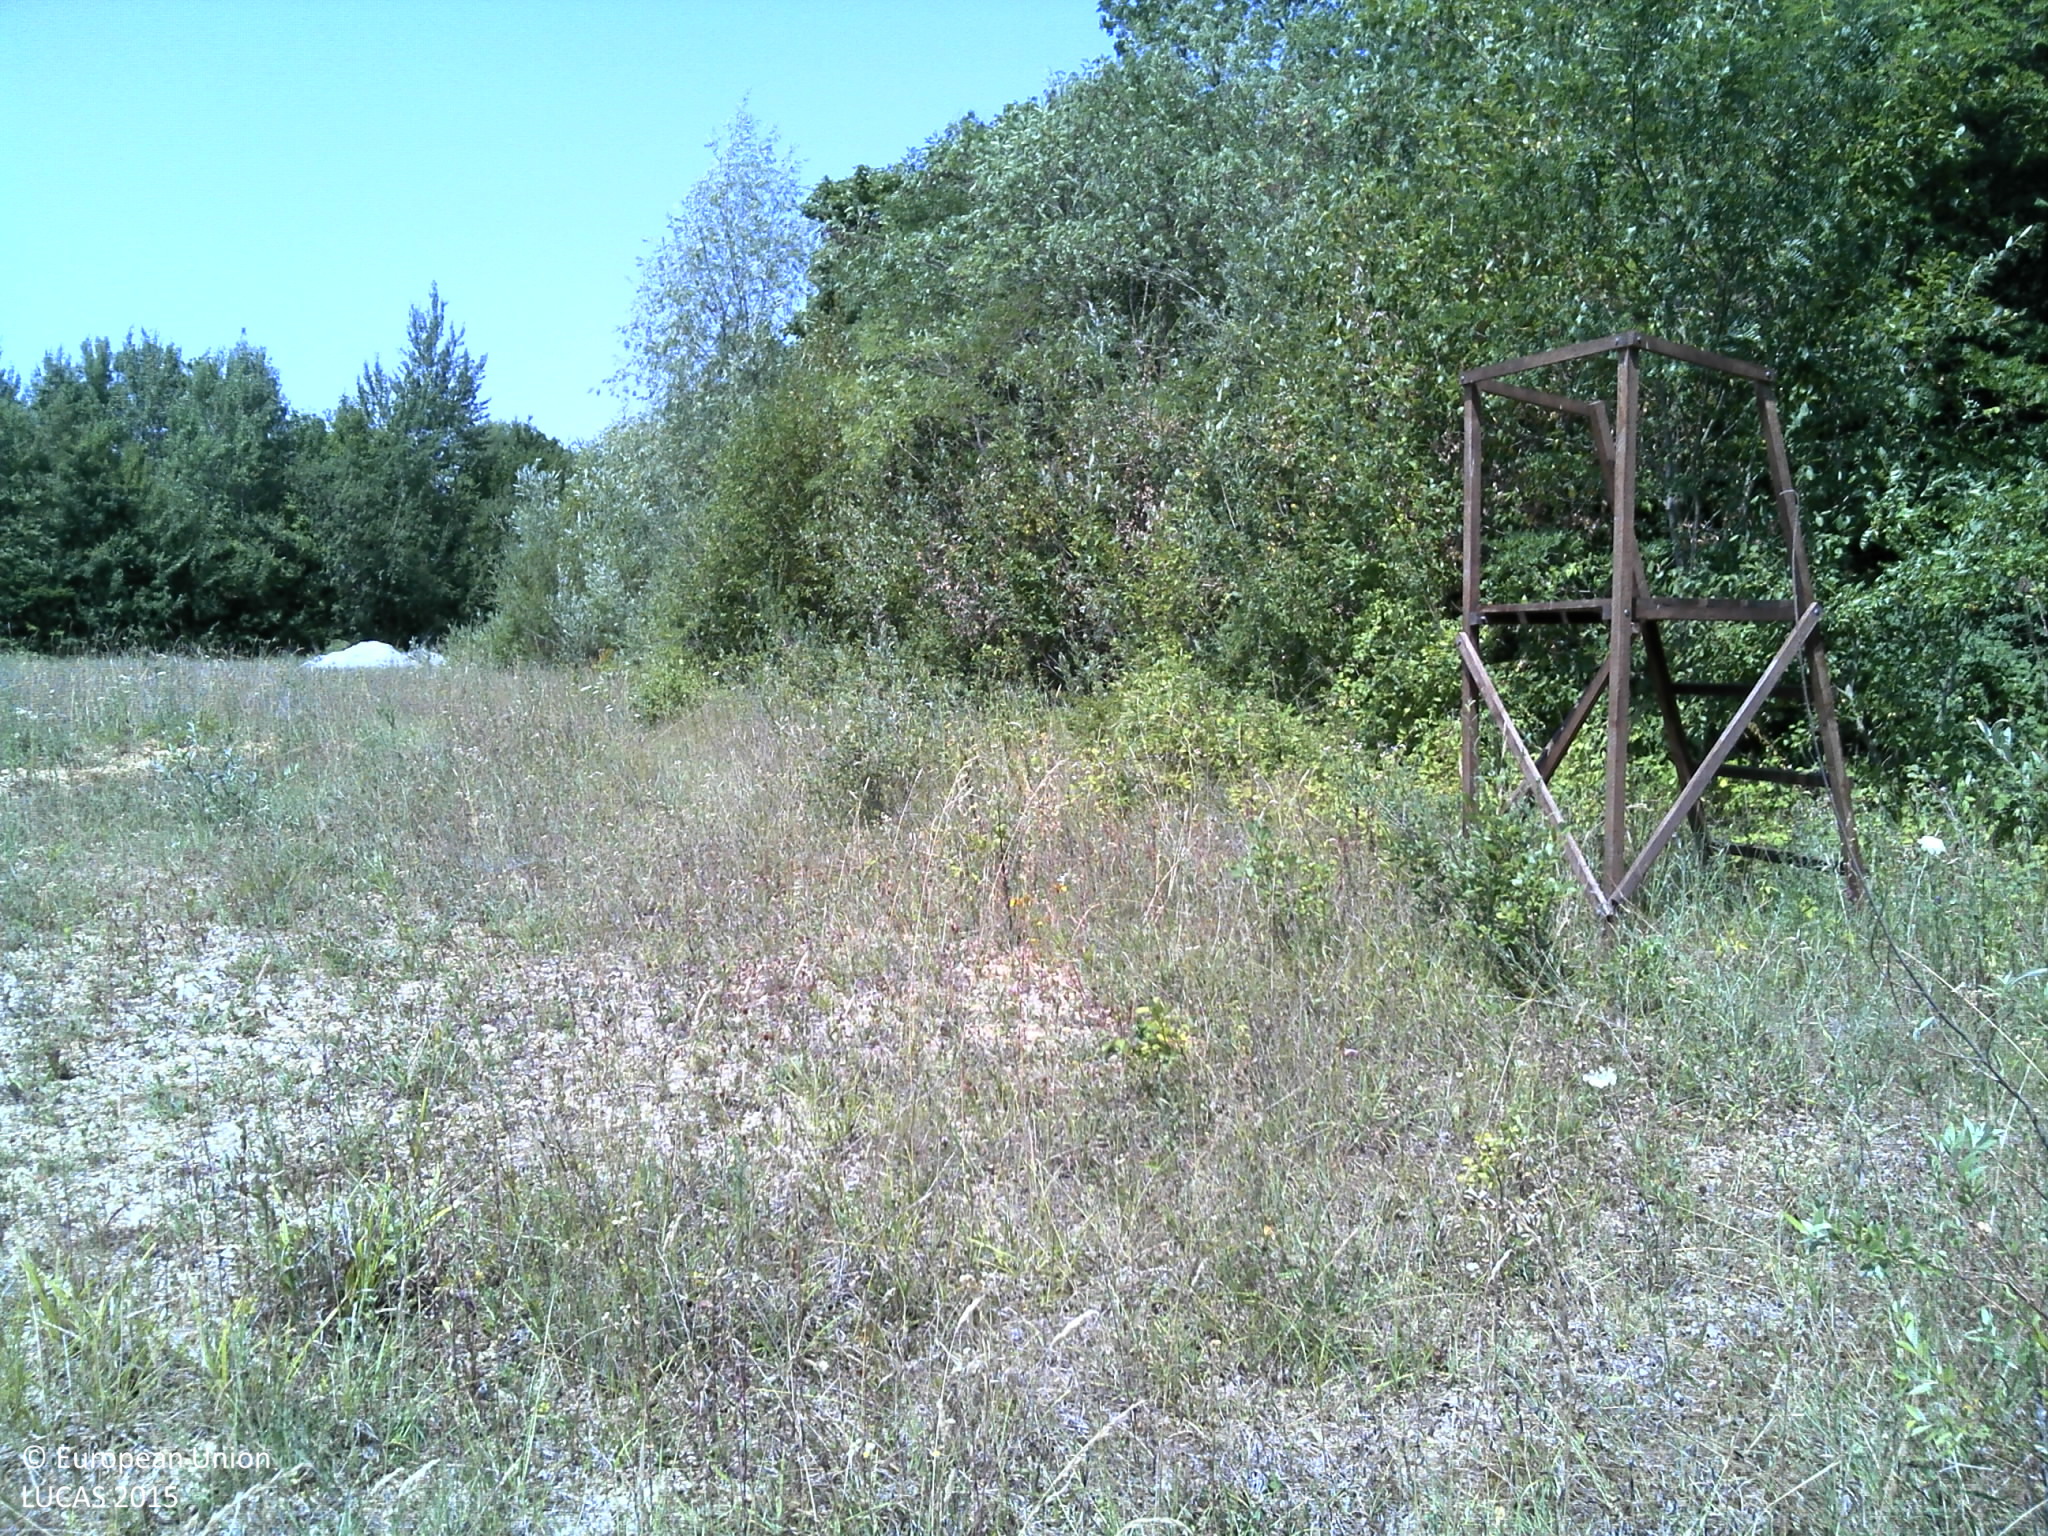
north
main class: Woodland
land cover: Broadleaved woodland
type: beech forest
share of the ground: > 75 %
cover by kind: broadleaved forest trees 85 %, coniferous forest trees 10 %, herbaceous plants 5 %
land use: Forestry
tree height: > 5 m
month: July
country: FR
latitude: 48.8441
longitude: 4.8879
